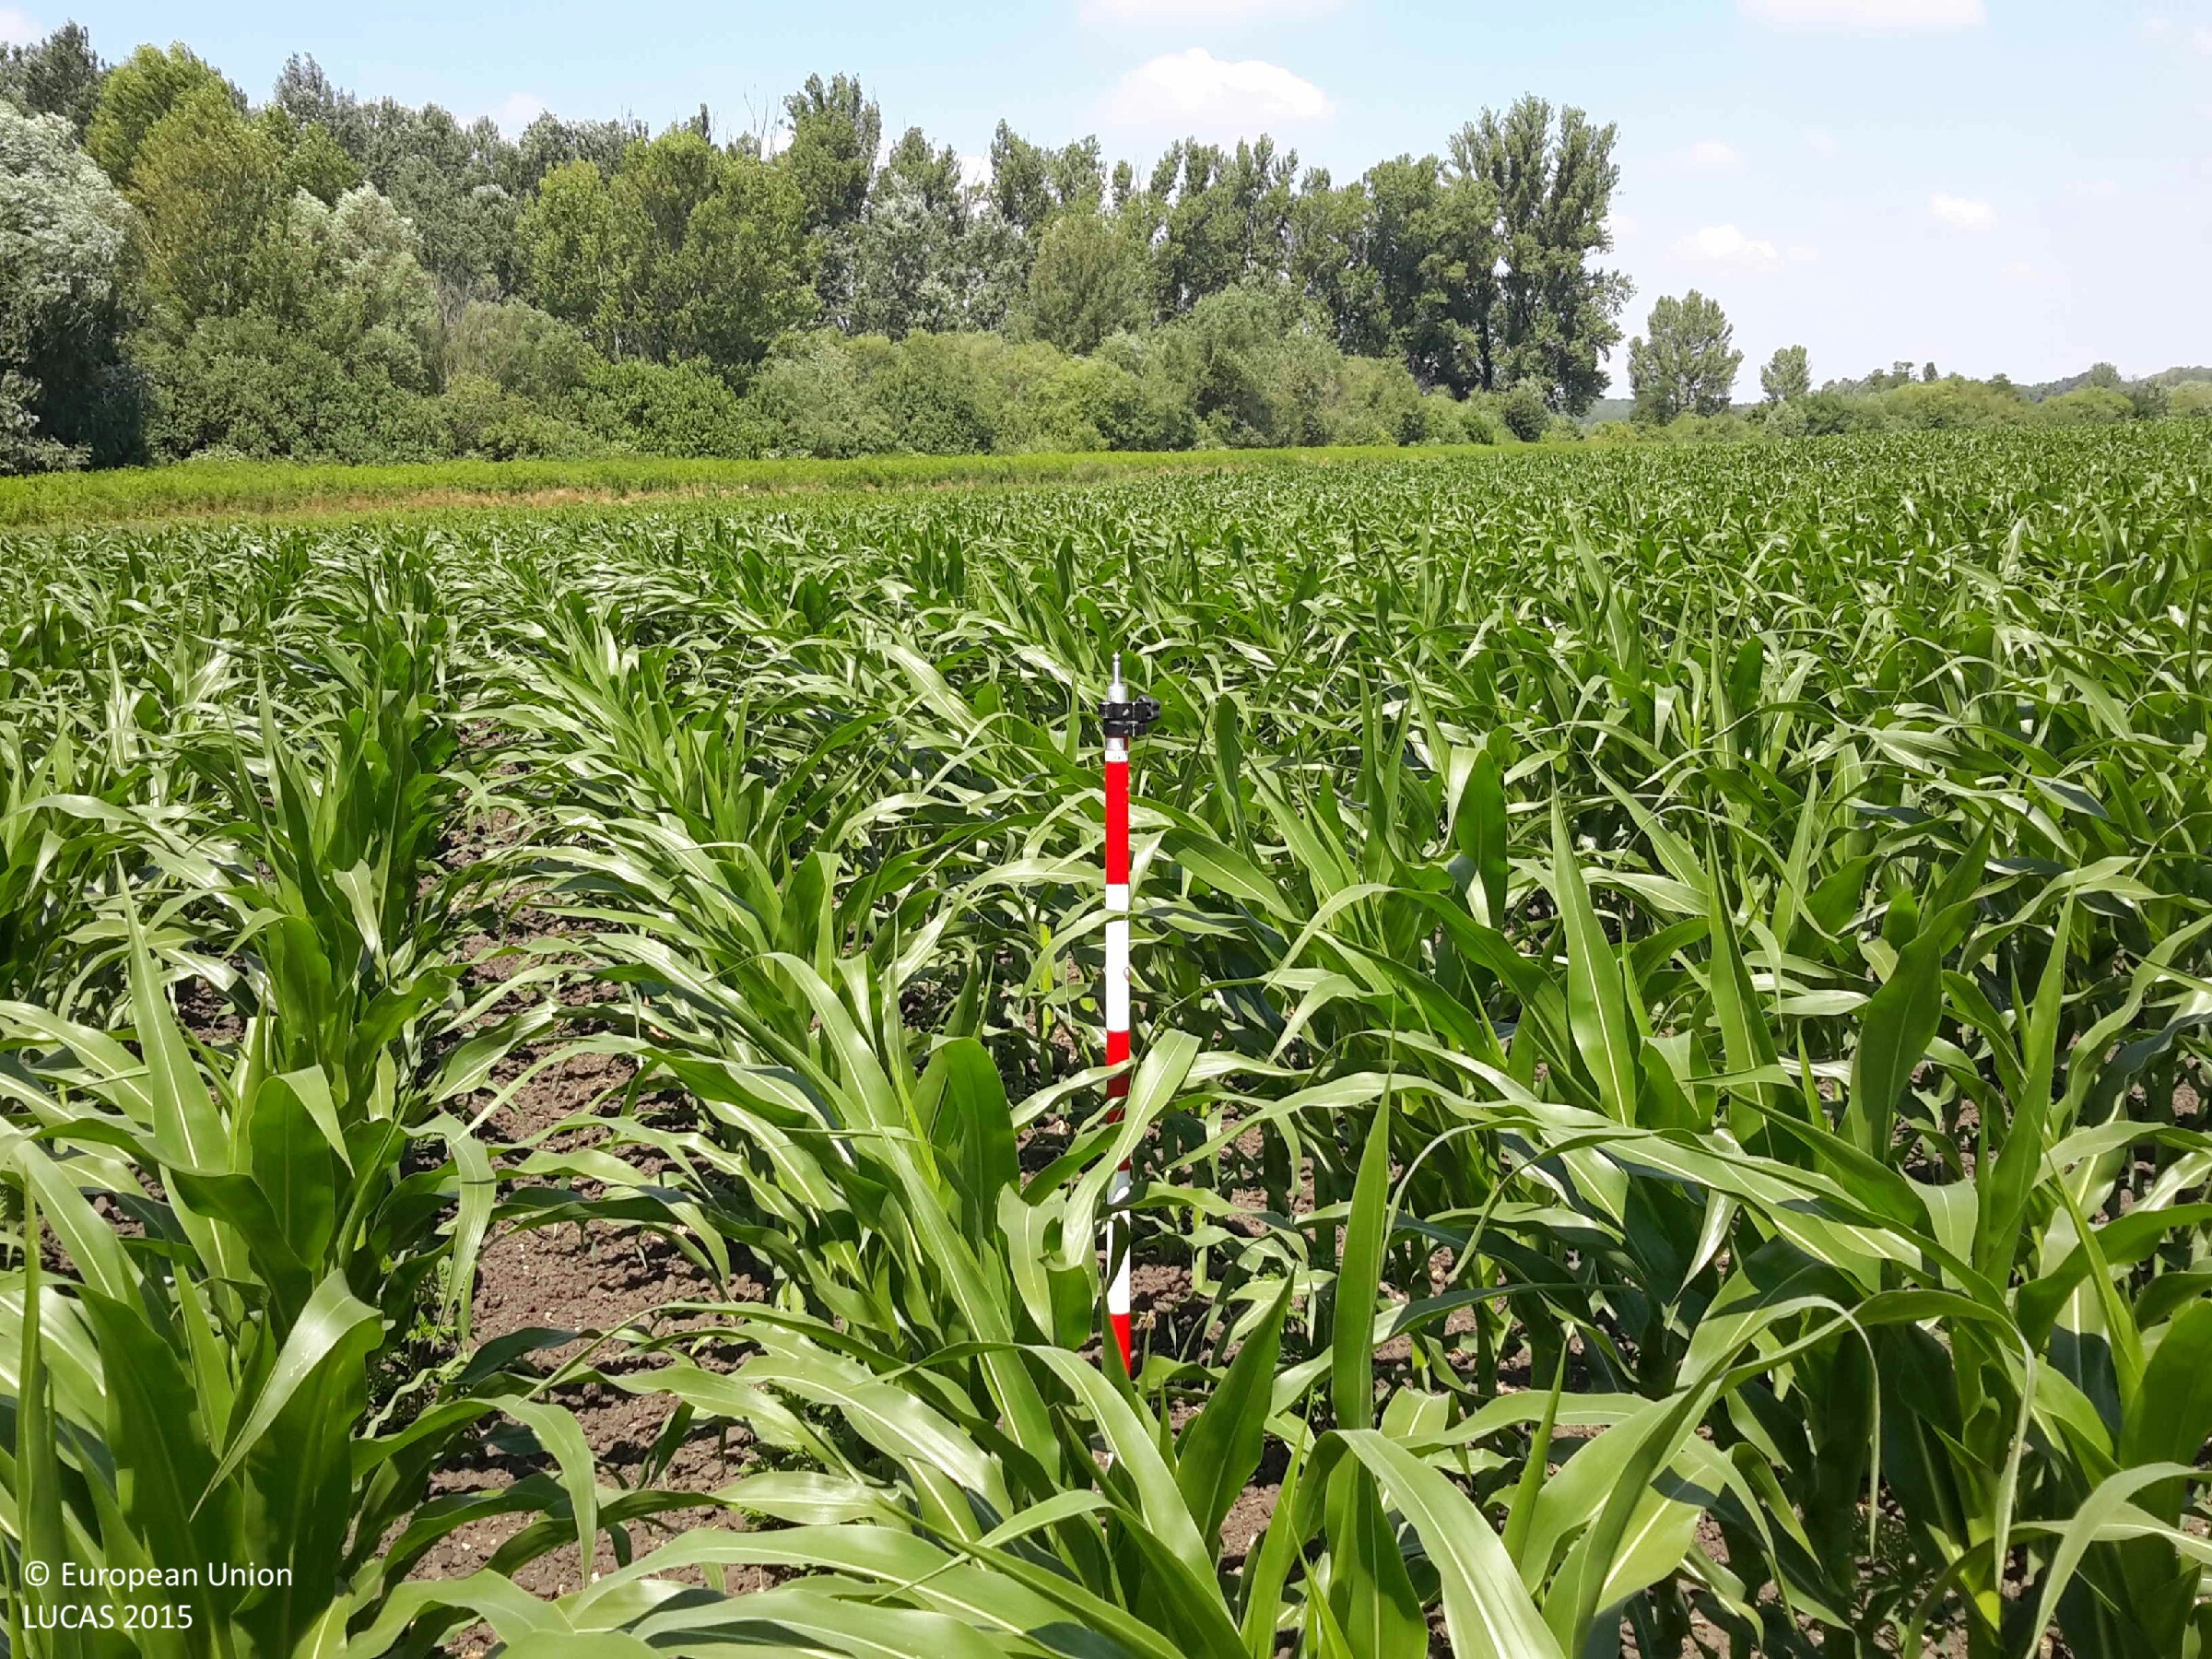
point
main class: Cropland
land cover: Maize
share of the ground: > 75 %
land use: Agriculture (excluding fallow land and kitchen gardens)
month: June
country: HU
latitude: 47.6836
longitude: 17.4283
